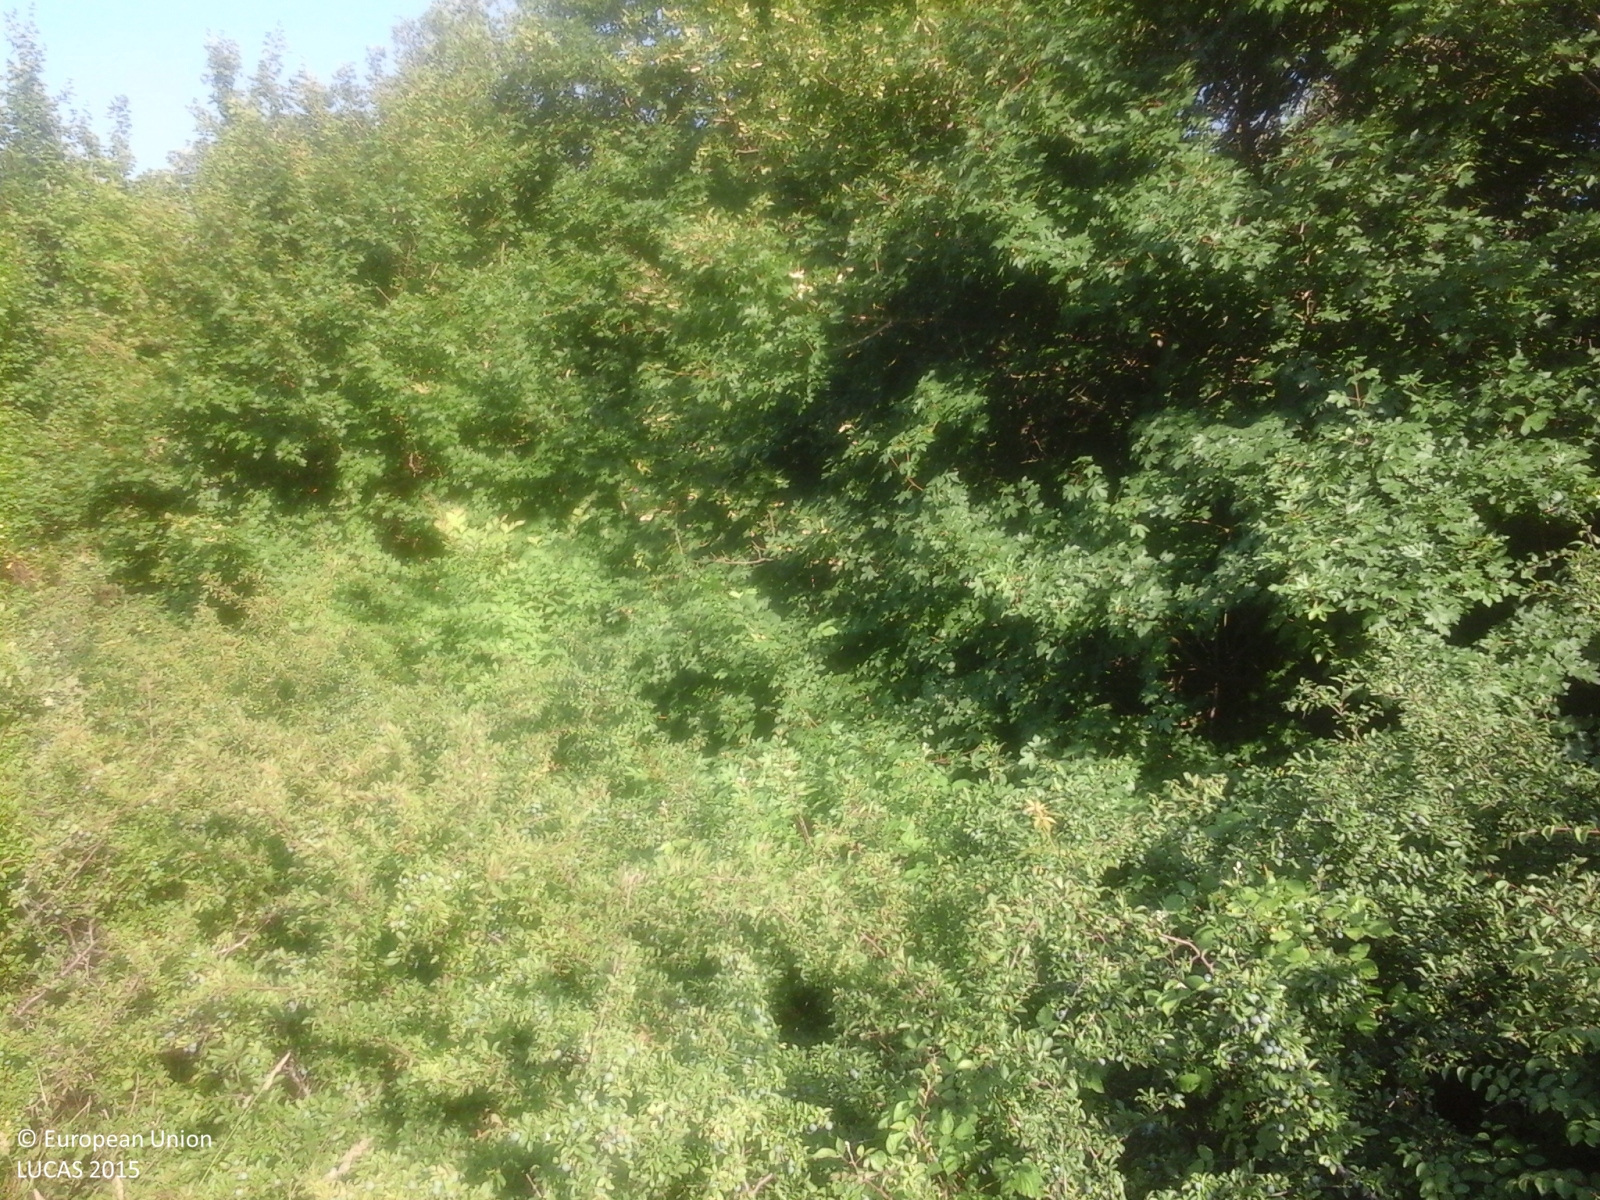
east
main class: Grassland
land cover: Grassland without tree/shrub cover
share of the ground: 25 - 50 %
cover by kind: herbaceous plants 95 %, shrubs 5 %
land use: Abandoned areas
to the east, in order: Grassland without tree/shrub cover; Broadleaved woodland; Olive groves; Broadleaved woodland; Ditches and canals; Broadleaved woodland; Grassland without tree/shrub cover; Broadleaved woodland; Railways; Broadleaved woodland; Olive groves; Electric lines; Olive groves
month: June
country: IT
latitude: 42.0362
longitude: 14.3468
